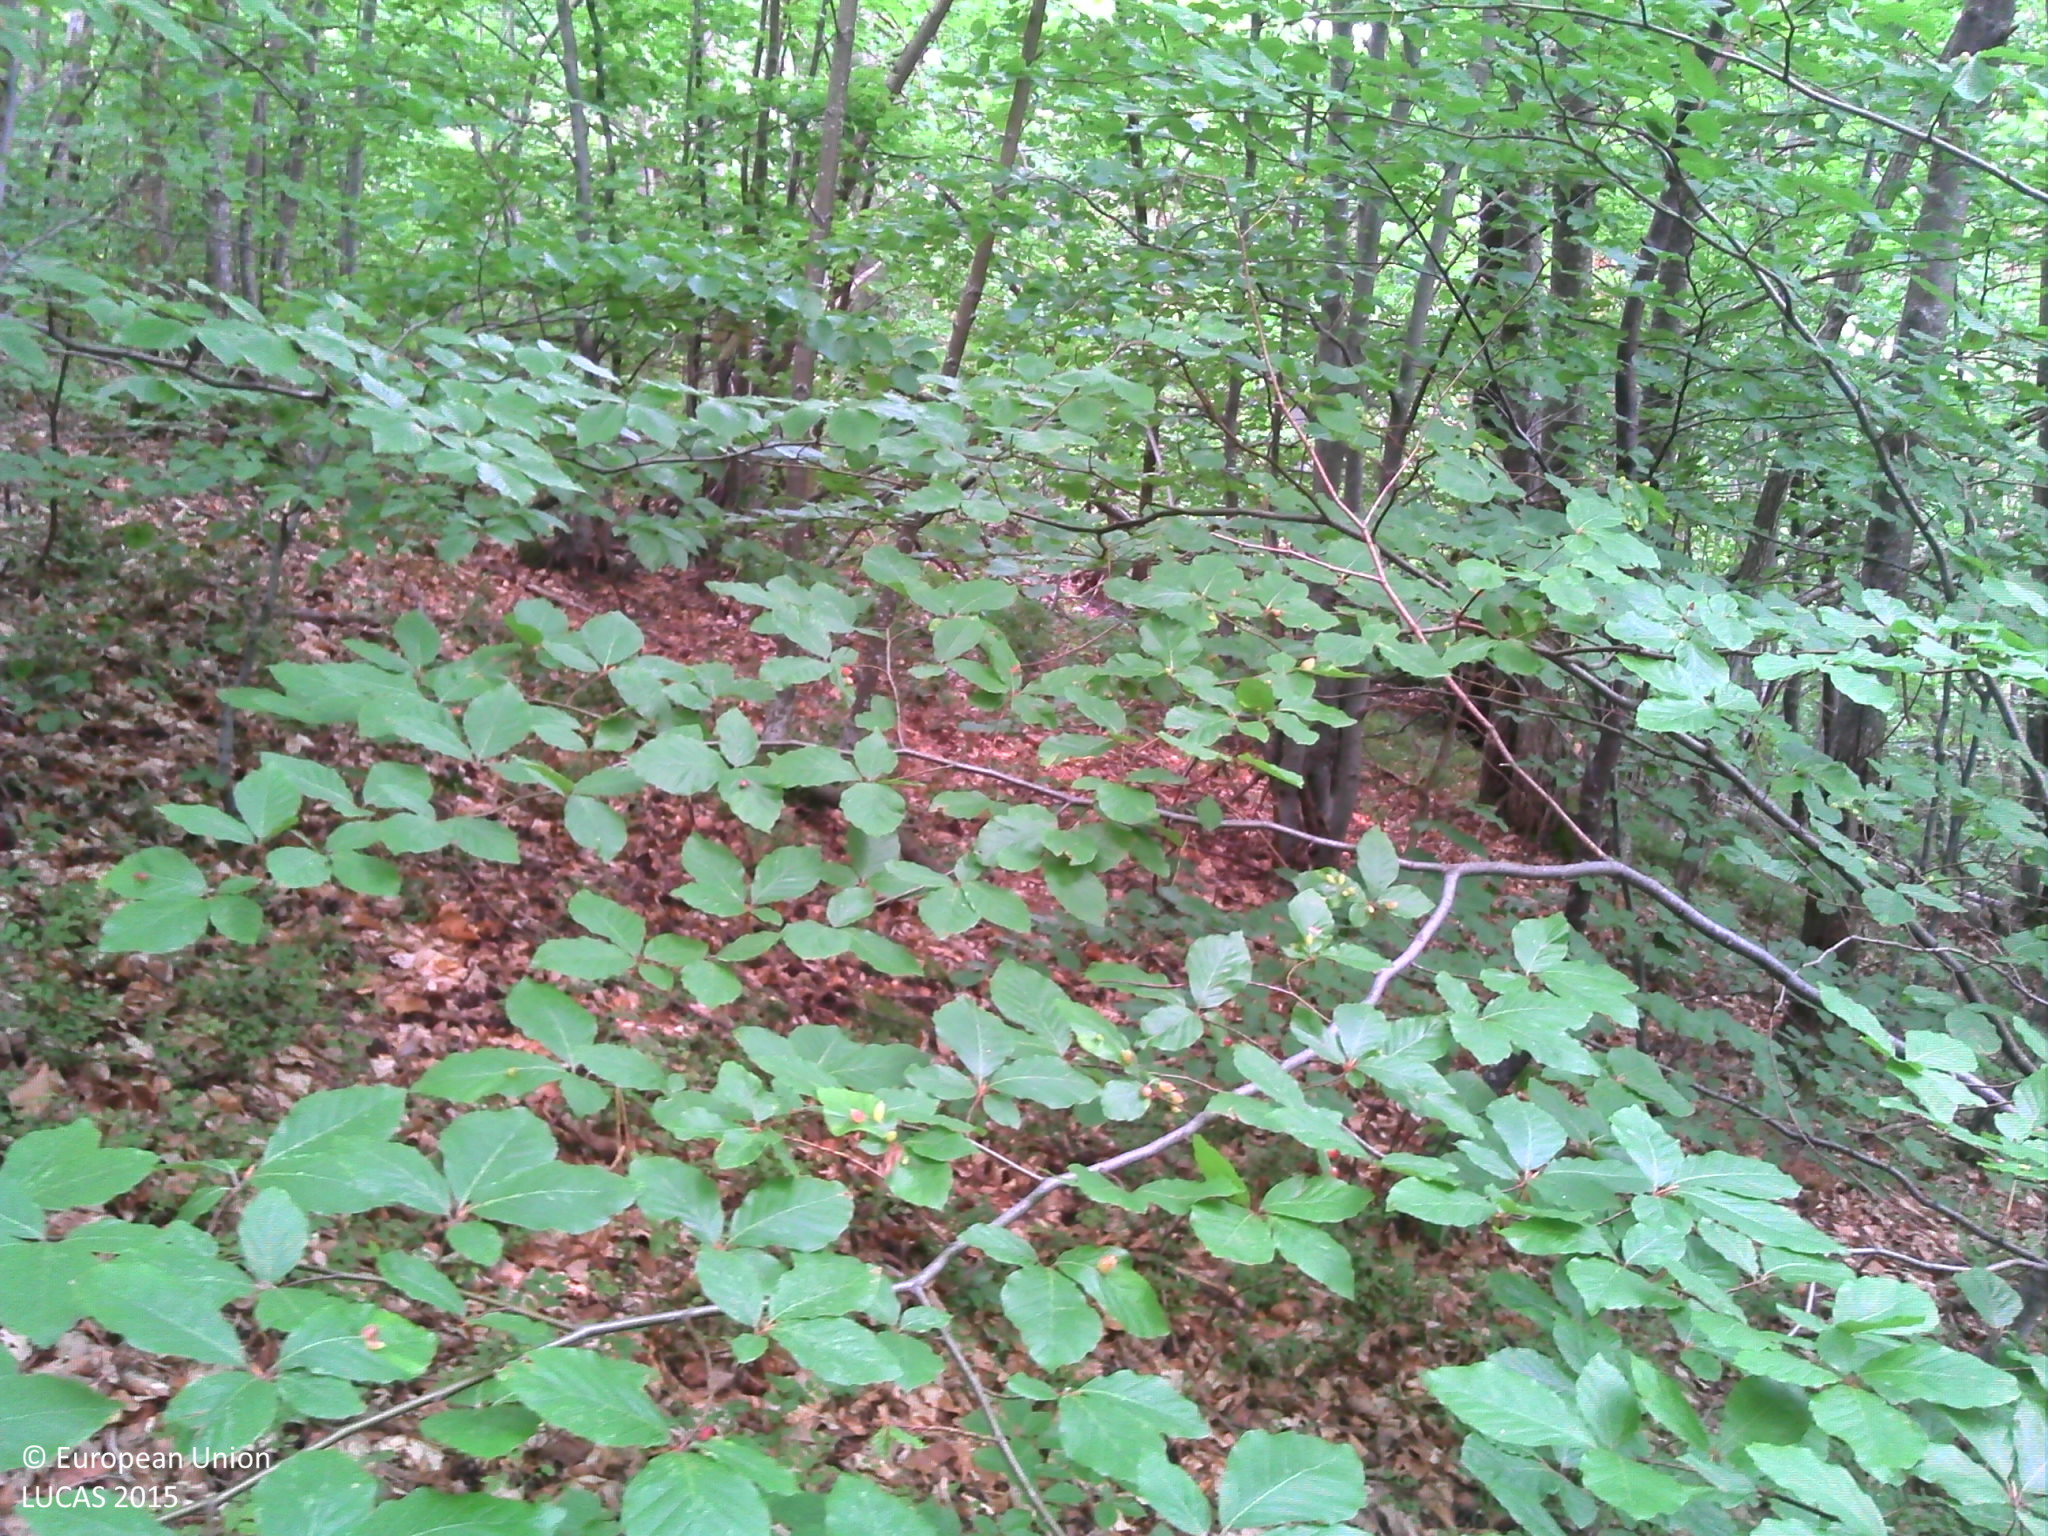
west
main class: Woodland
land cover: Pine dominated mixed woodland
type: mountainous beech forest
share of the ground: > 75 %
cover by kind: broadleaved forest trees 50 %, coniferous forest trees 25 %, unconsolidated bare surface 15 %, shrubs 5 %, herbaceous plants 5 %
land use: Forestry
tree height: > 5 m
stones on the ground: < 10 %
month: August
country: FR
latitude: 45.0390
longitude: 4.5592
